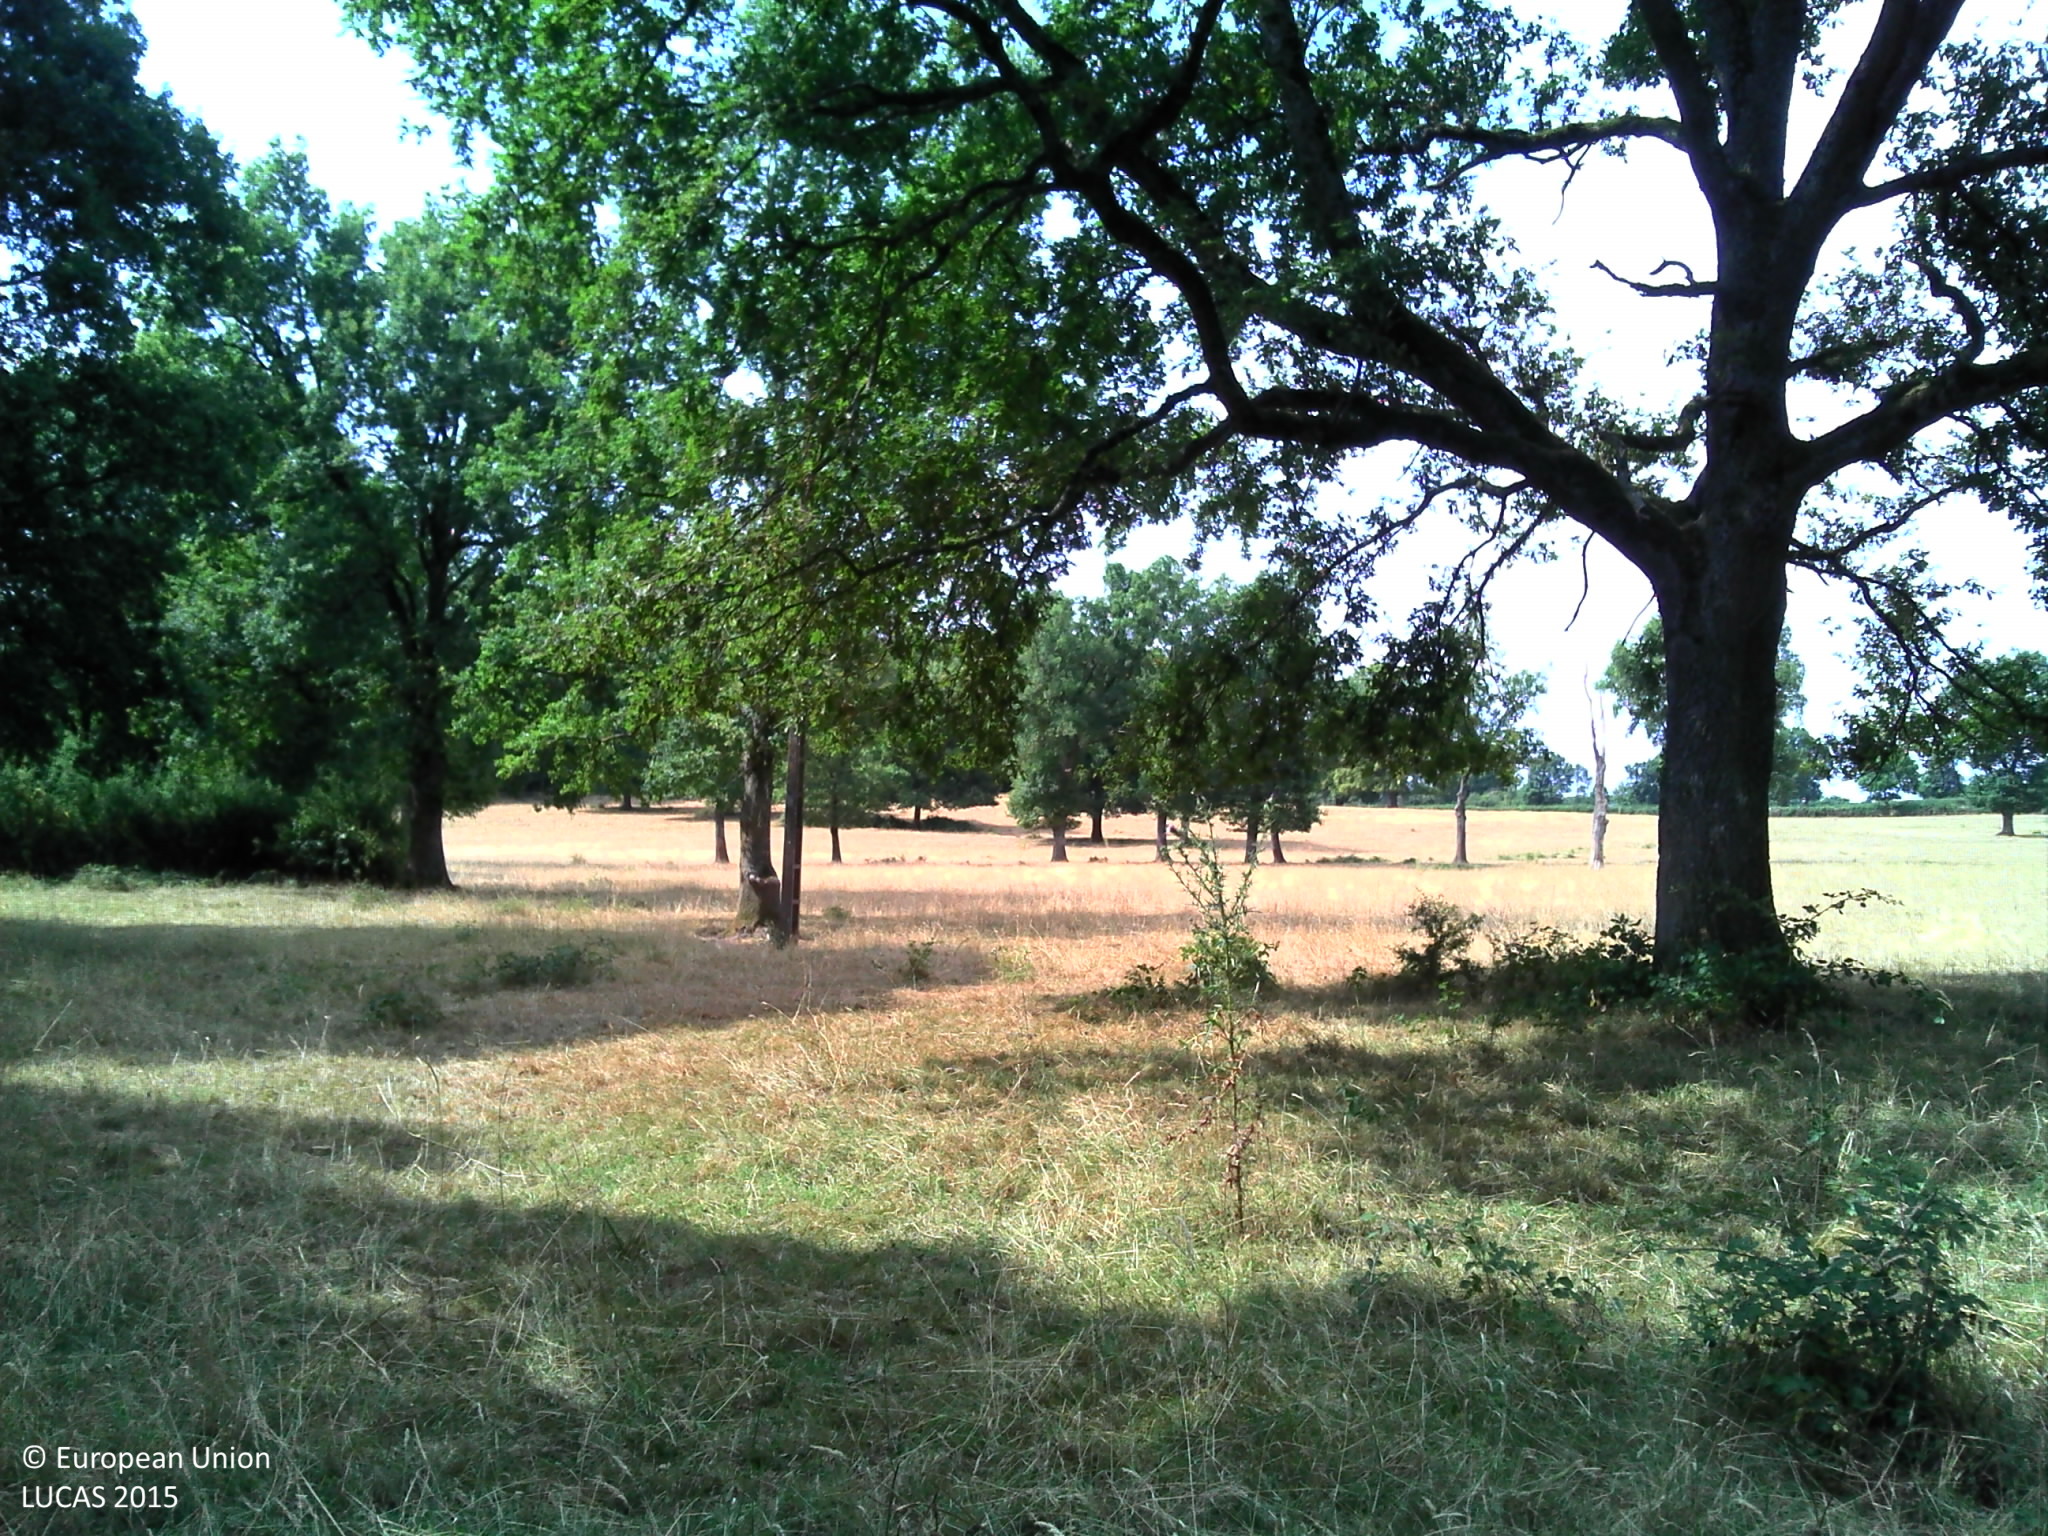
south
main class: Grassland
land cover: Grassland with sparse tree/shrub cover
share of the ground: > 75 %
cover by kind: herbaceous plants 85 %, shrubs 10 %, broadleaved forest trees 5 %
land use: Agriculture (excluding fallow land and kitchen gardens)
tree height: > 5 m
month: July
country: FR
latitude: 46.6301
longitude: 3.0351
